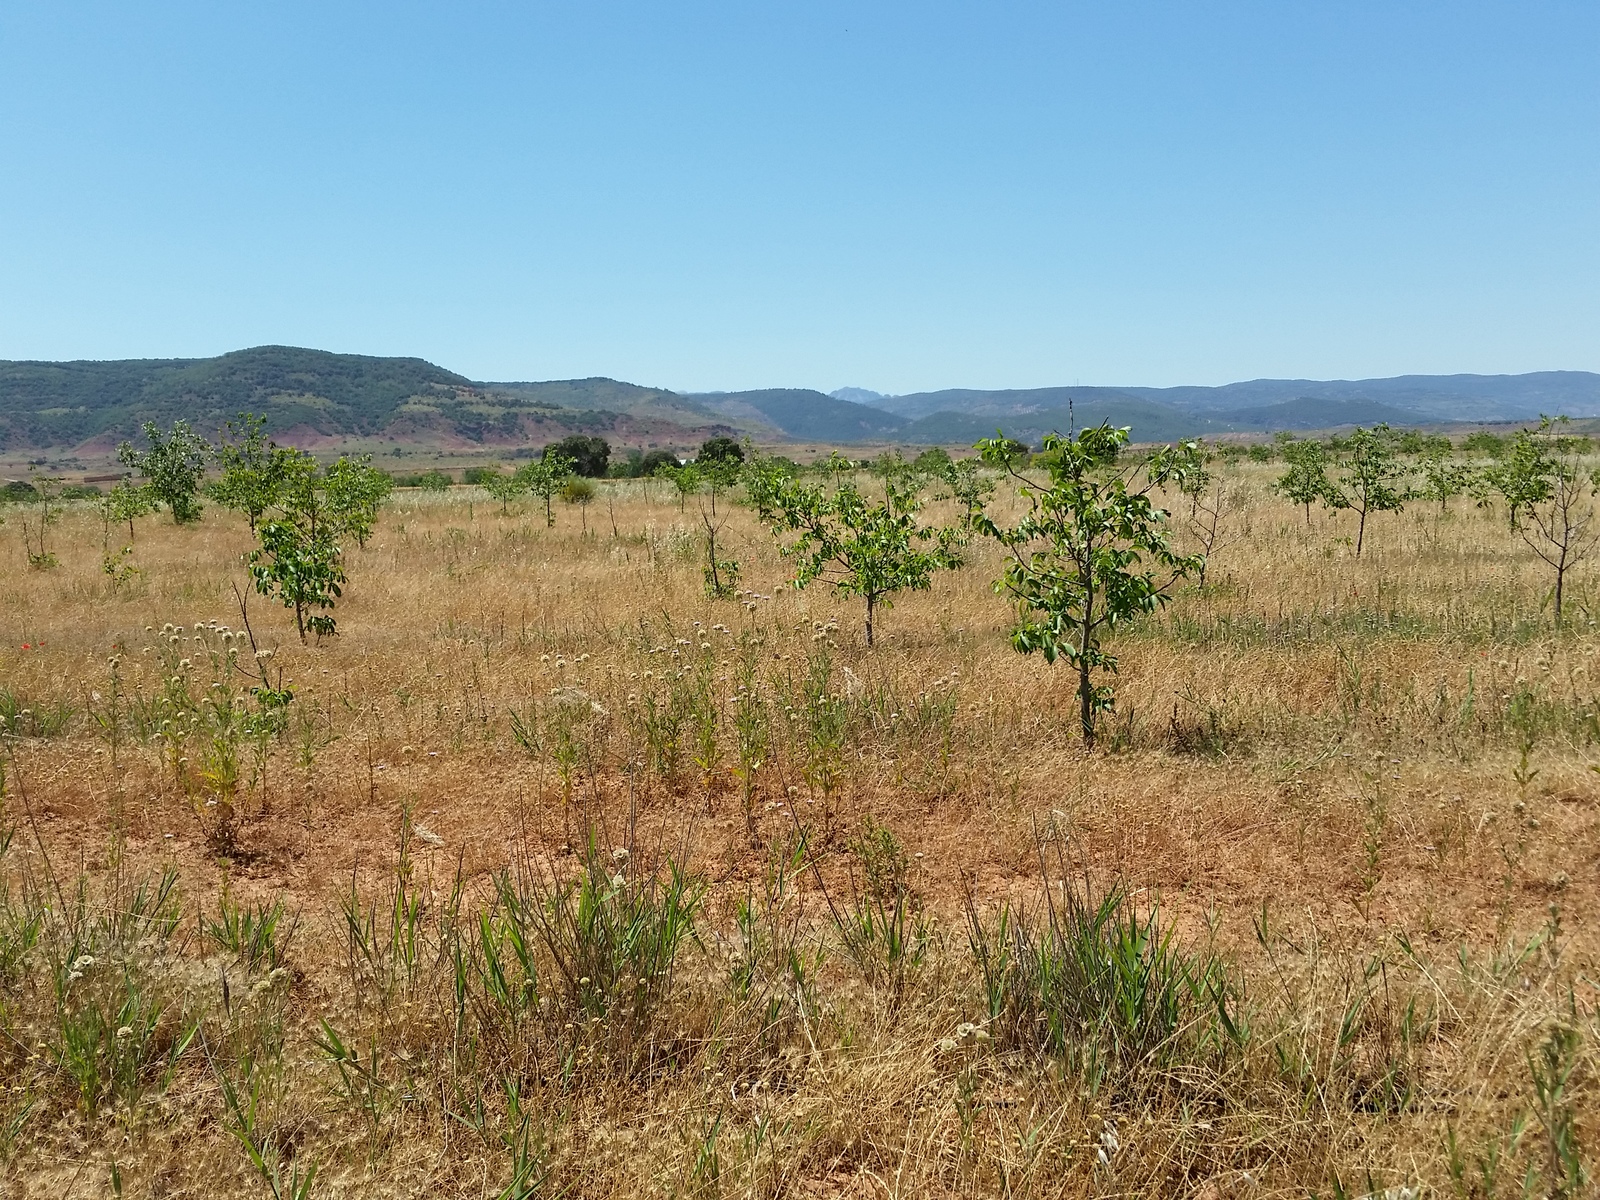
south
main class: Cropland
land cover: Nuts trees
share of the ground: 25 - 50 %
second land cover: Grassland without tree/shrub cover
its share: > 75 %
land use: Agriculture (excluding fallow land and kitchen gardens)
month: June
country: ES
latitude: 38.6694
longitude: -2.5641
